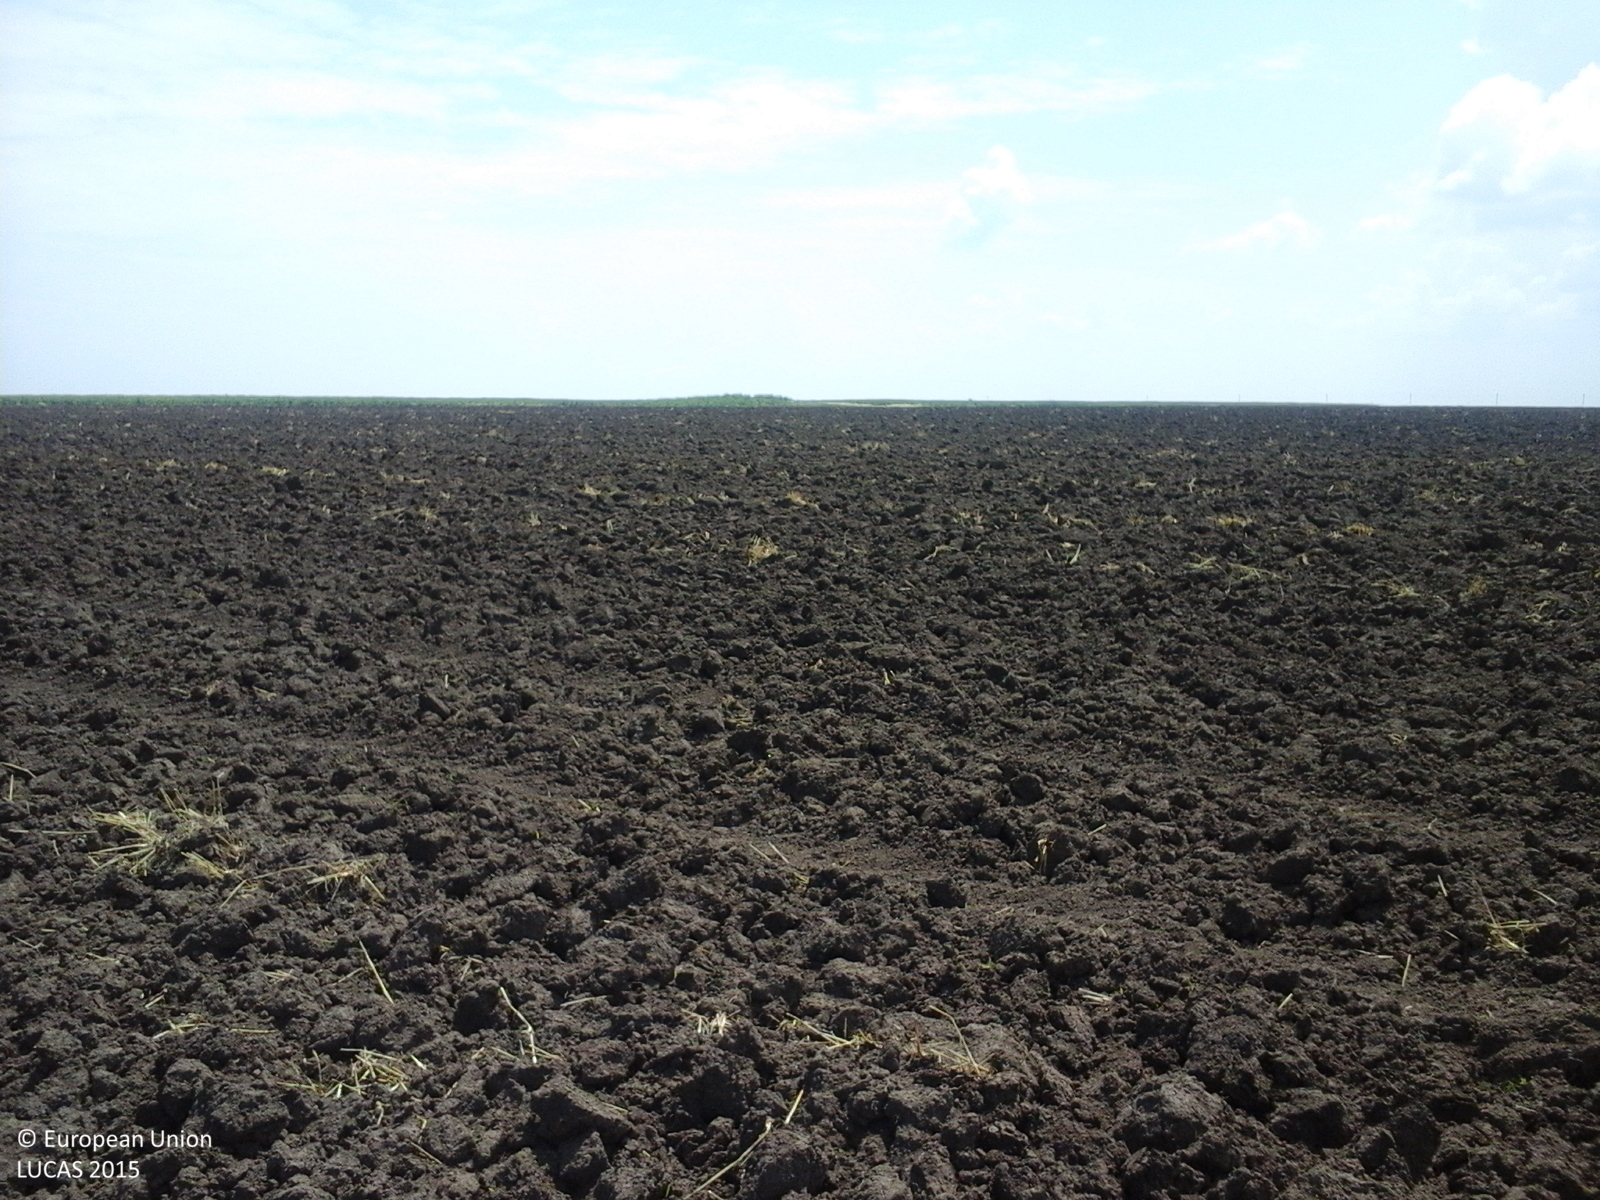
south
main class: Cropland
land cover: Common wheat
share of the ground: < 10 %
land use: Agriculture (excluding fallow land and kitchen gardens)
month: July
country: RO
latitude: 44.0900
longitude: 25.7684
